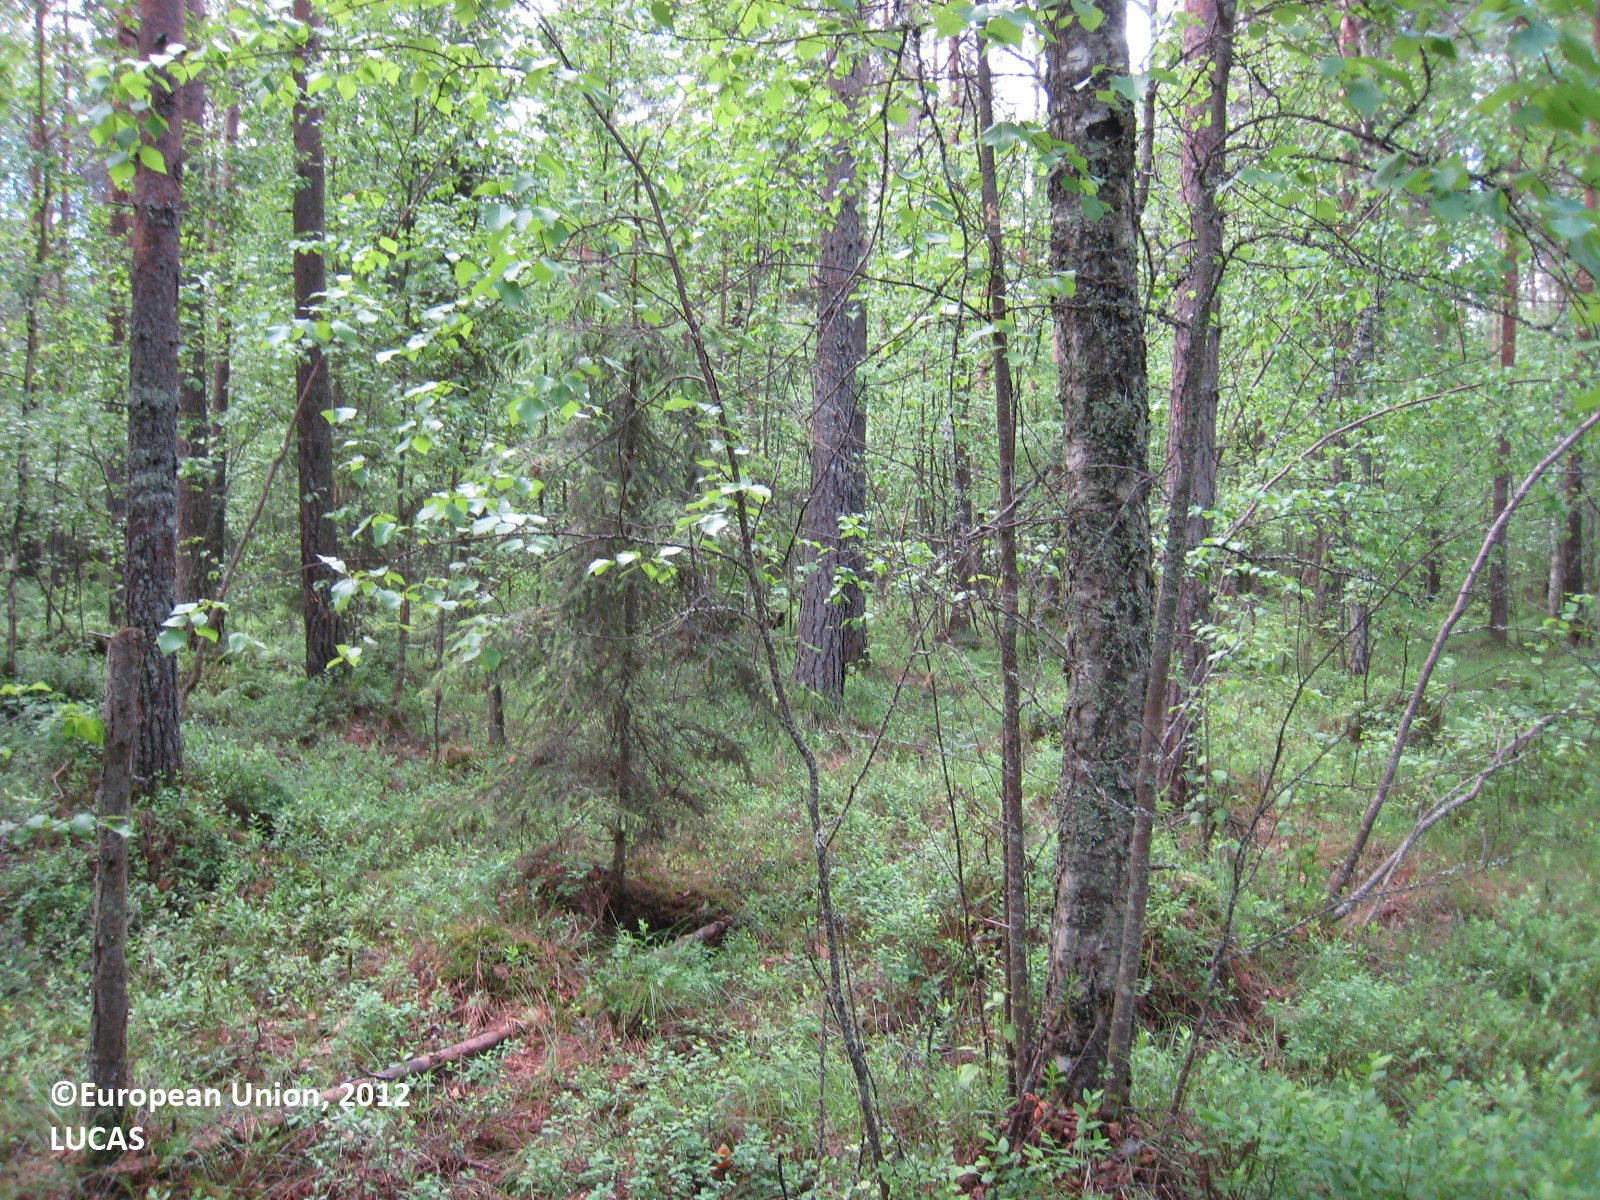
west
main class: Woodland
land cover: Pine dominated mixed woodland
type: boreal forest
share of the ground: 50 - 75 %
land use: Forestry
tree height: > 5 m
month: June
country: FI
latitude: 62.4895
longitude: 25.9782
